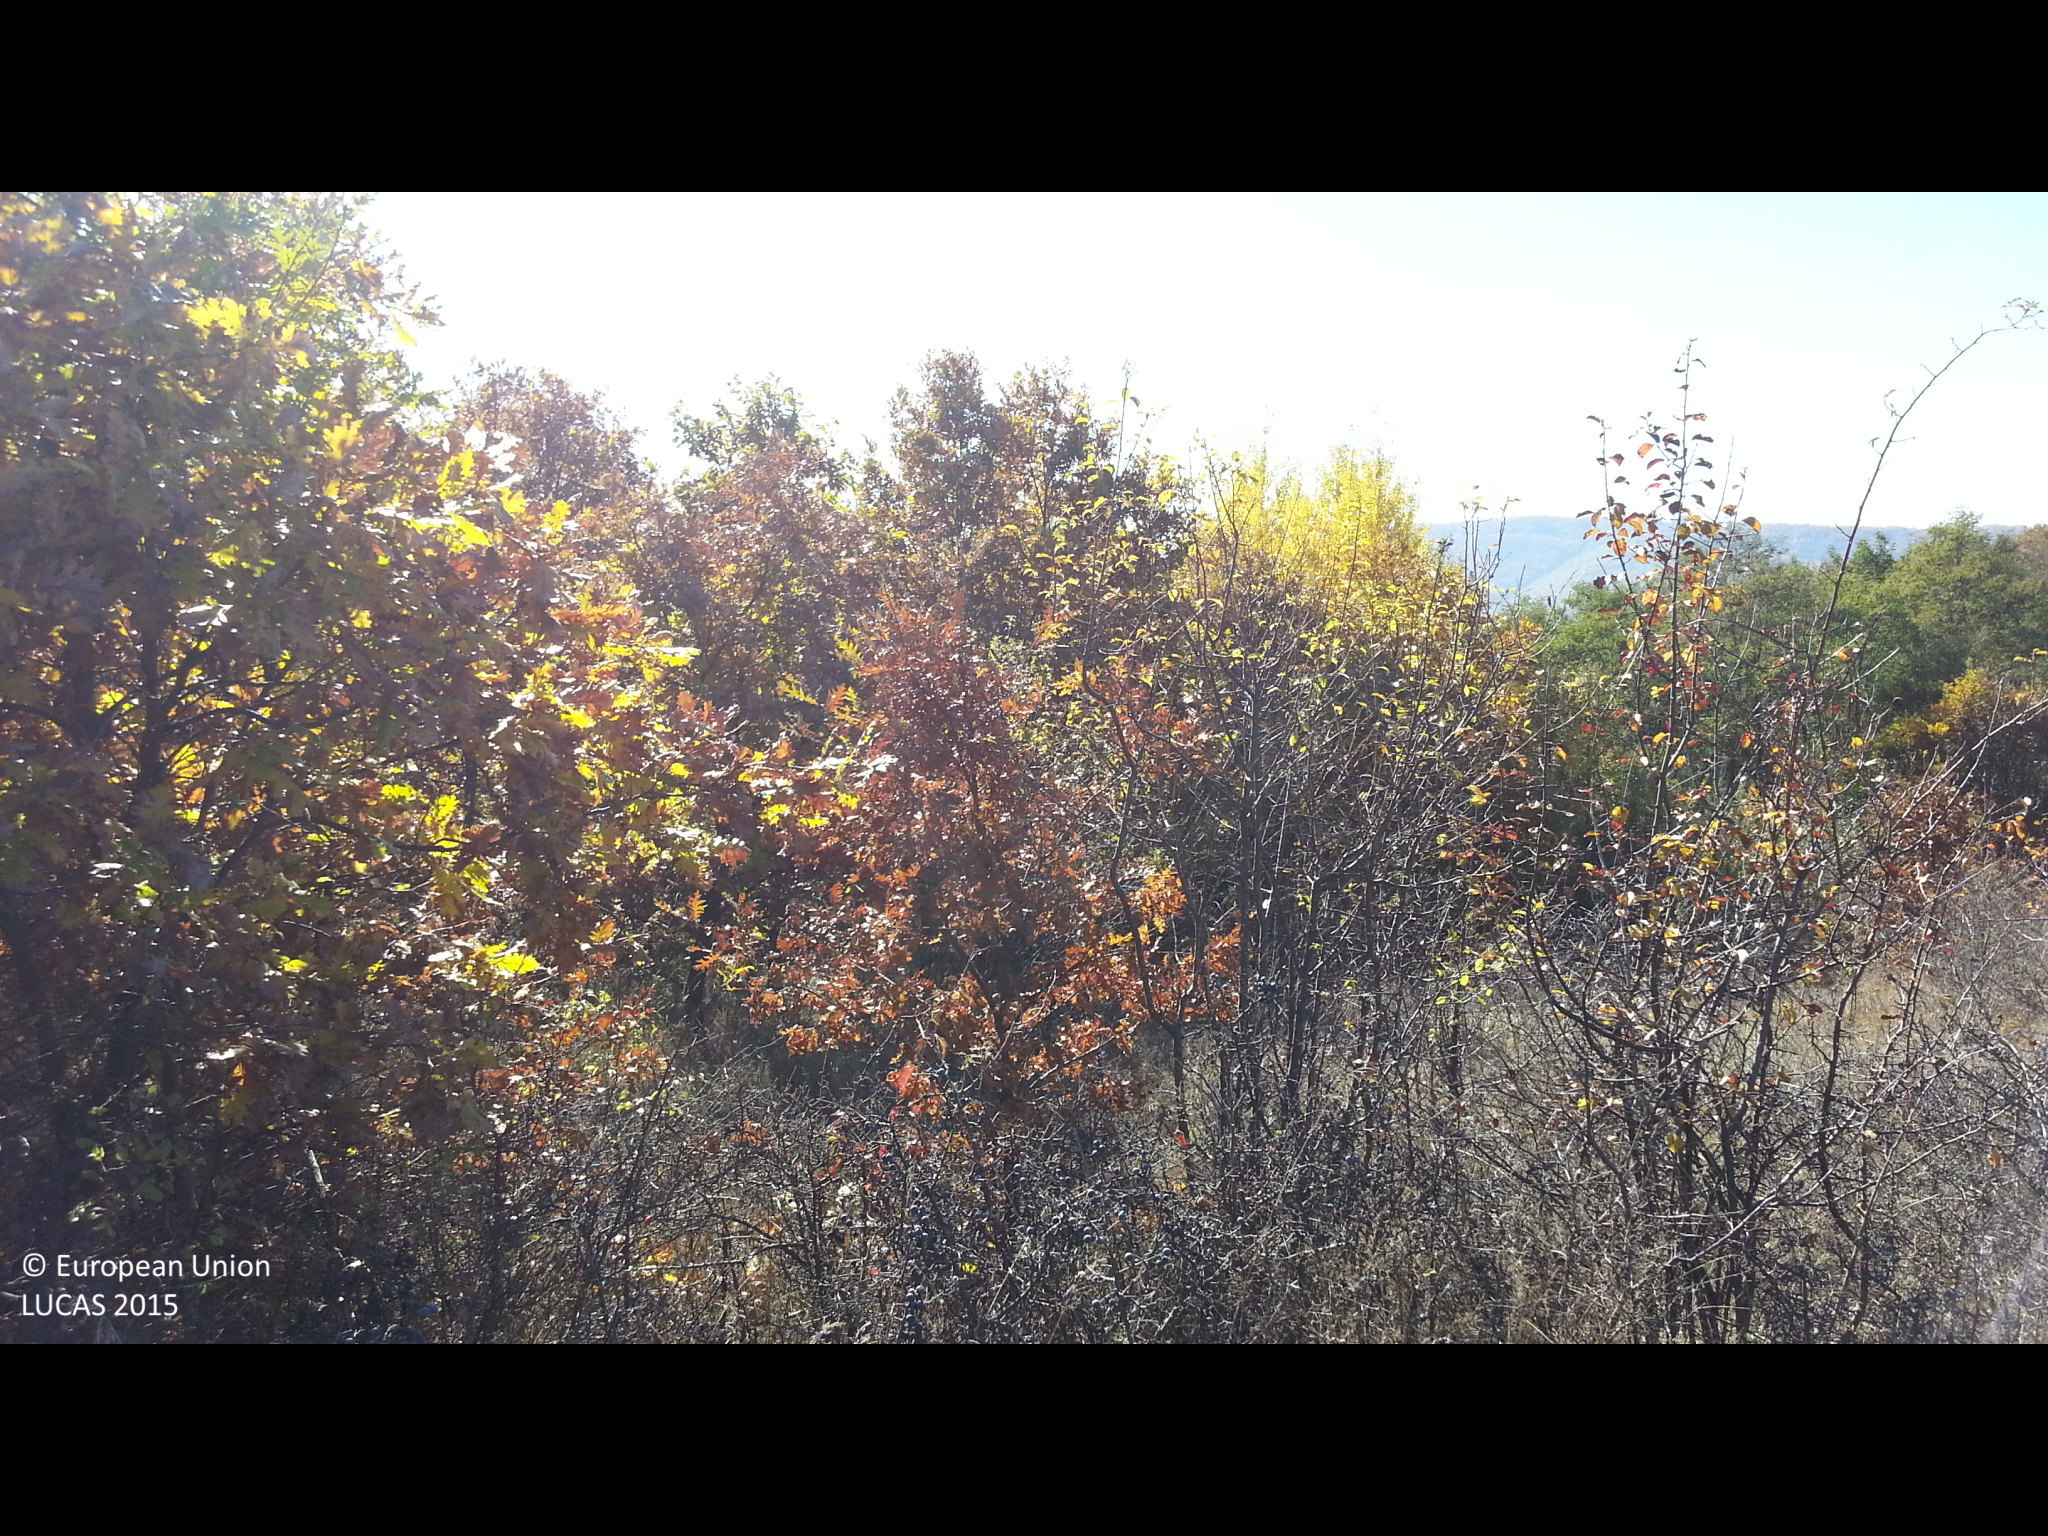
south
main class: Shrubland
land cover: Shrubland with sparse tree cover
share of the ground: 25 - 50 %
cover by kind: herbaceous plants 55 %, shrubs 40 %, broadleaved forest trees 5 %
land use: Semi-natural and natural areas not in use
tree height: < 5 m
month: November
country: BG
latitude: 42.7079
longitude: 23.9501
